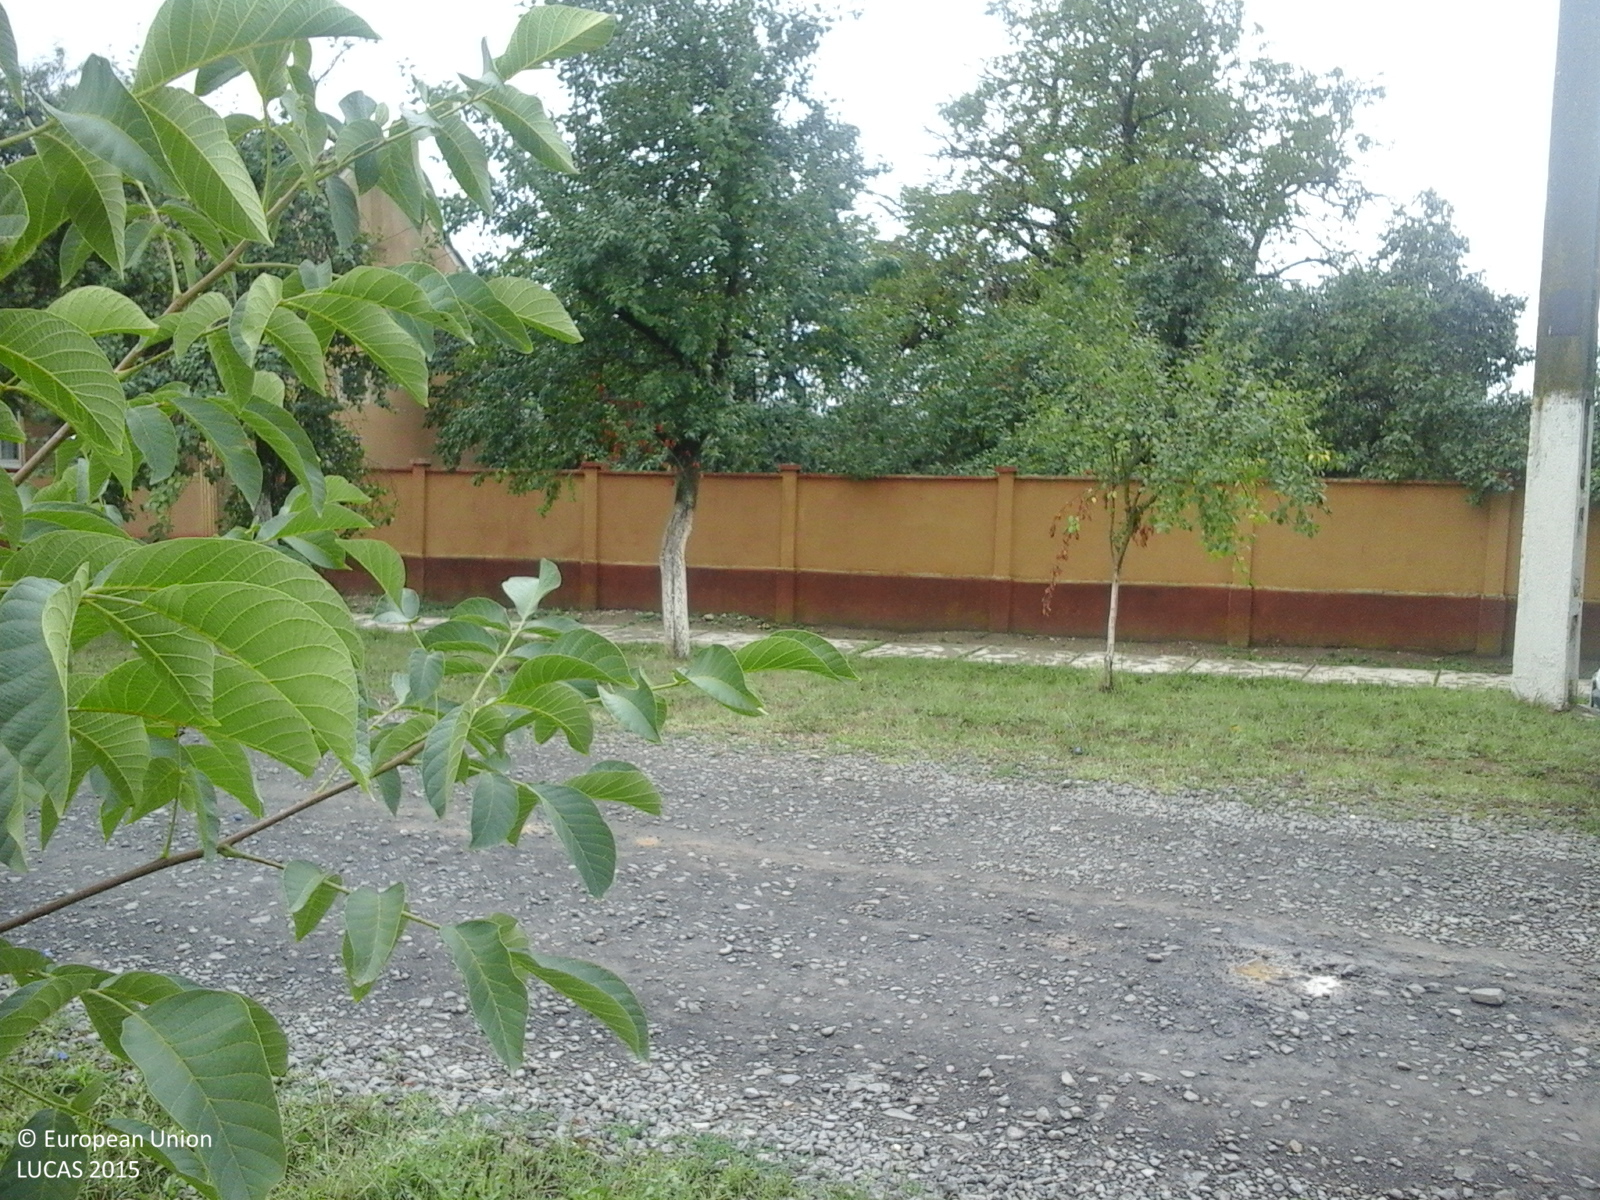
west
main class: Cropland
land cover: Lucerne
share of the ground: > 75 %
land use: Agriculture (excluding fallow land and kitchen gardens)
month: August
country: RO
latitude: 45.7203
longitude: 21.7409
